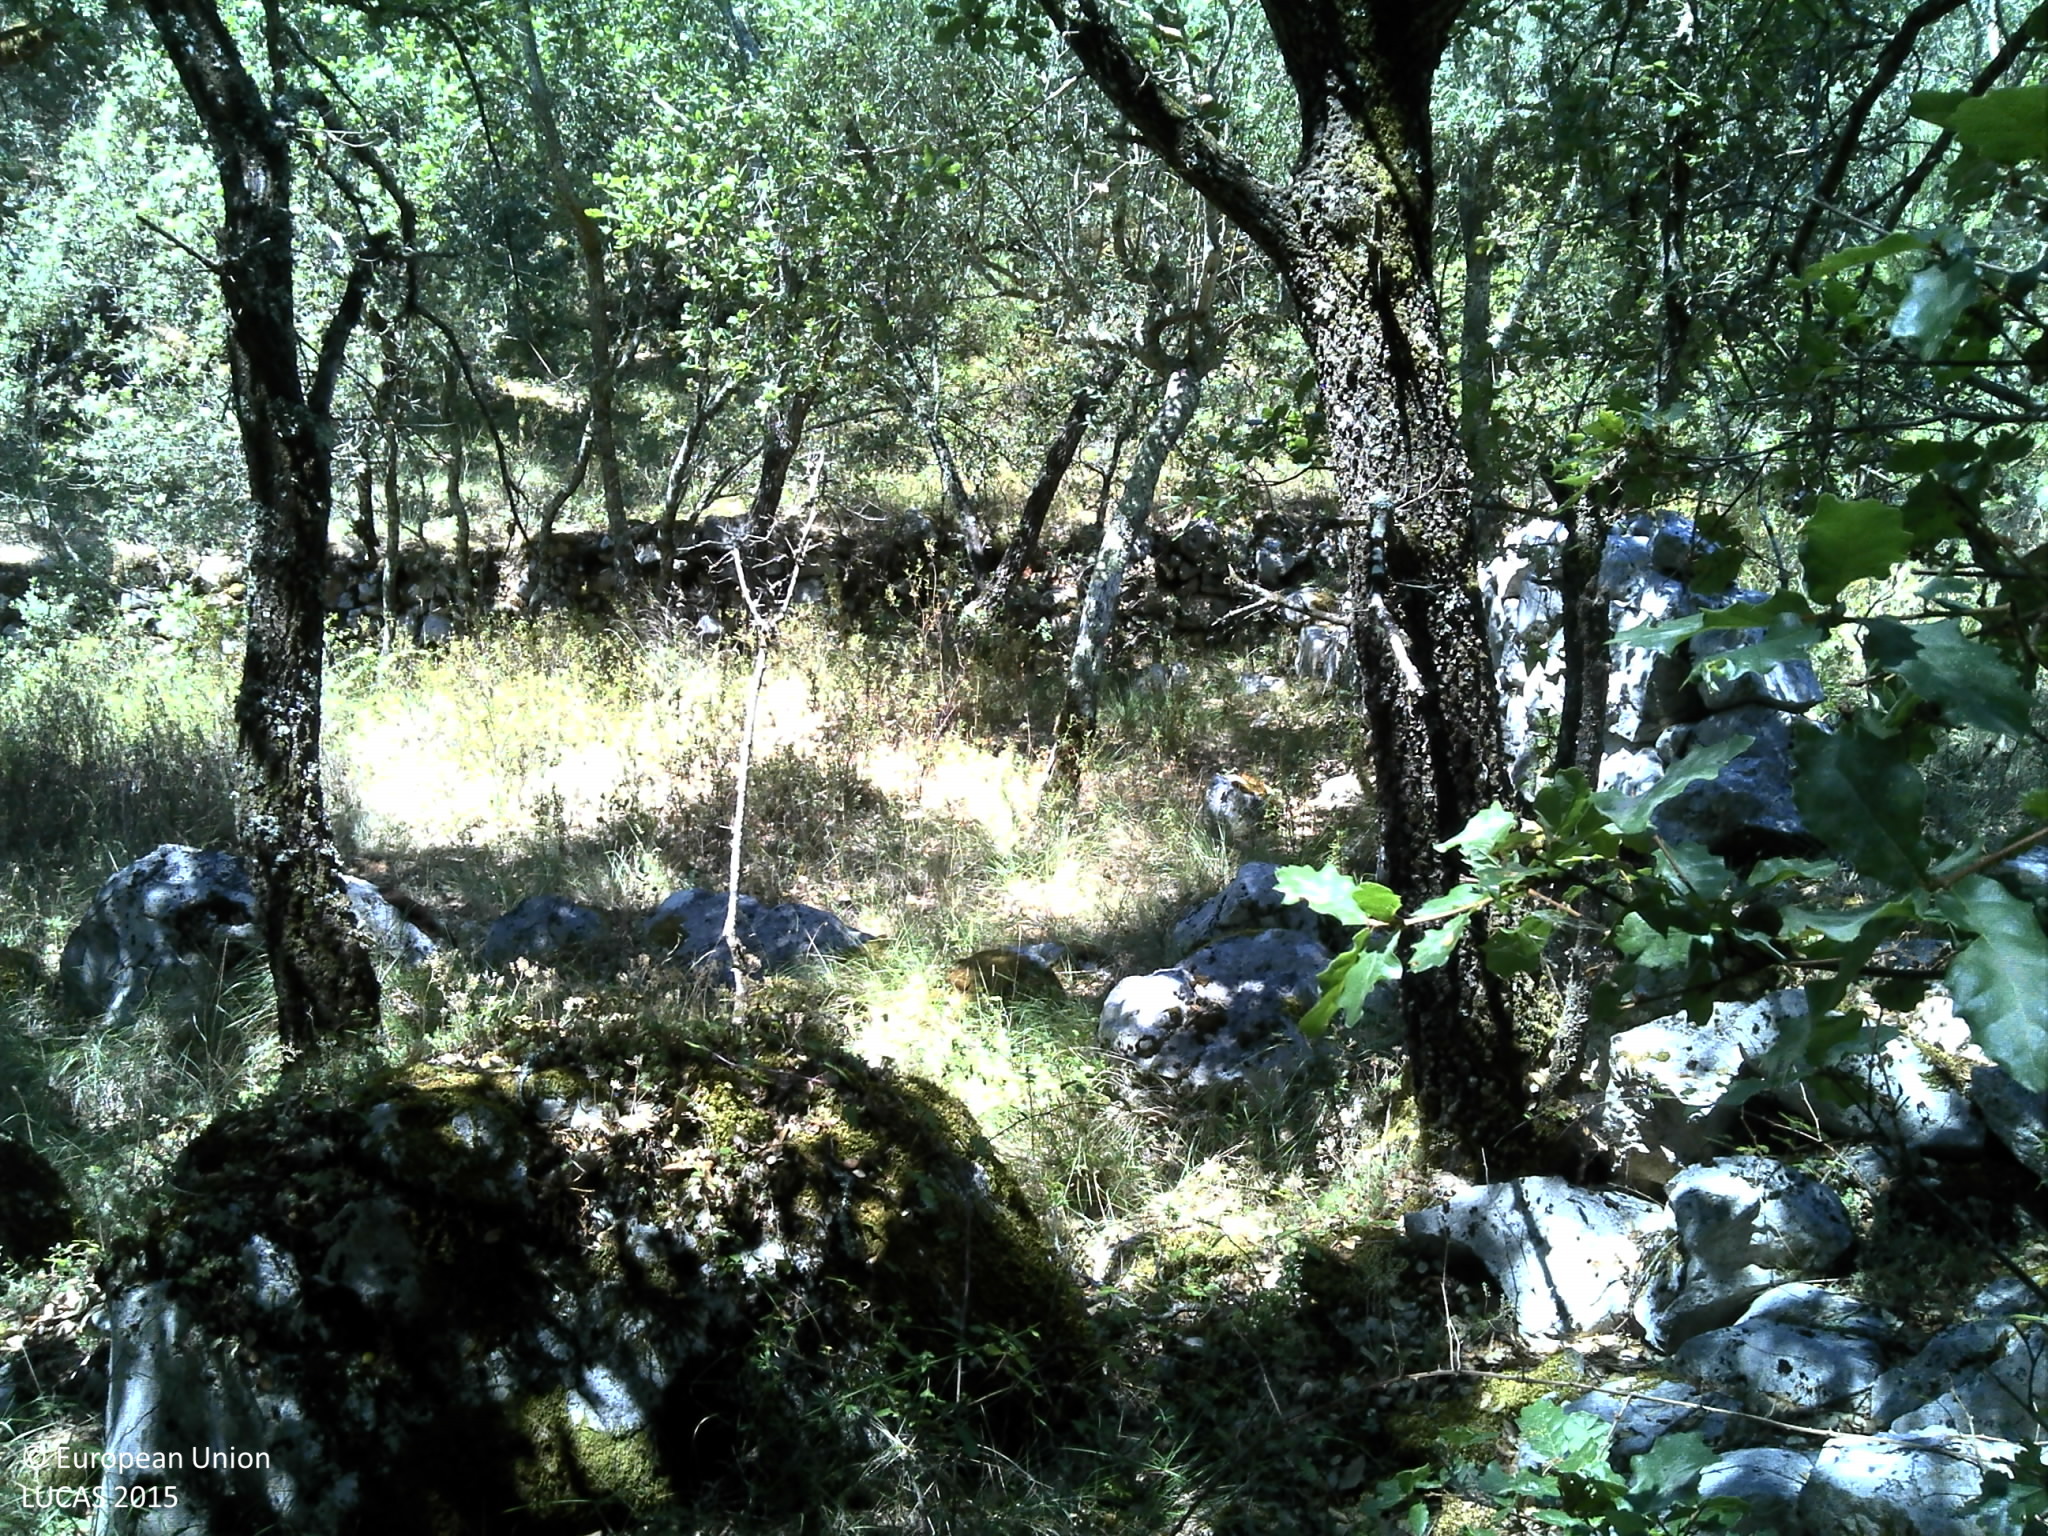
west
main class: Woodland
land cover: Broadleaved woodland
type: acidophilous oak and oak-birch forest
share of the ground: 50 - 75 %
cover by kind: broadleaved forest trees 55 %, herbaceous plants 30 %, unconsolidated bare surface 10 %, shrubs 5 %
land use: Forestry
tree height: > 5 m
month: July
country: PT
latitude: 39.8353
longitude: -8.4345
